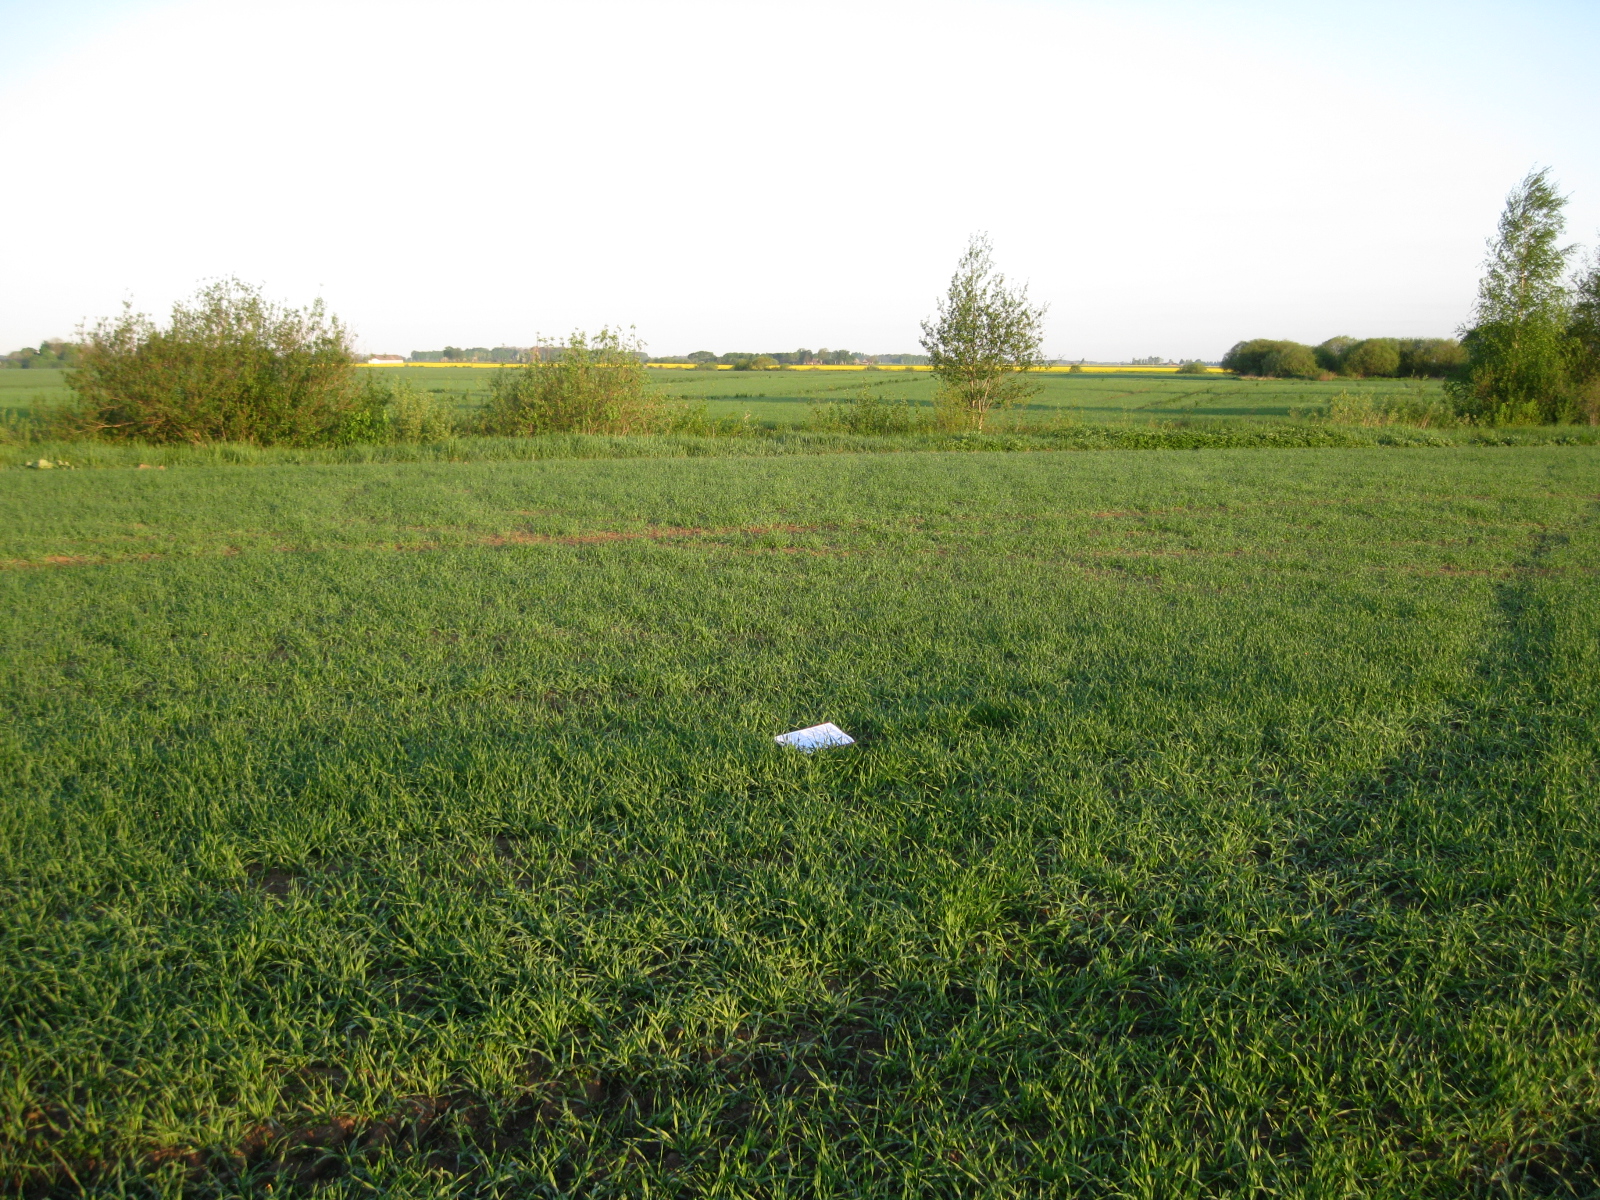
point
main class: Cropland
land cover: Barley
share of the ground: > 75 %
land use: Agriculture (excluding fallow land and kitchen gardens)
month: May
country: LT
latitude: 56.1133
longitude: 23.8005
